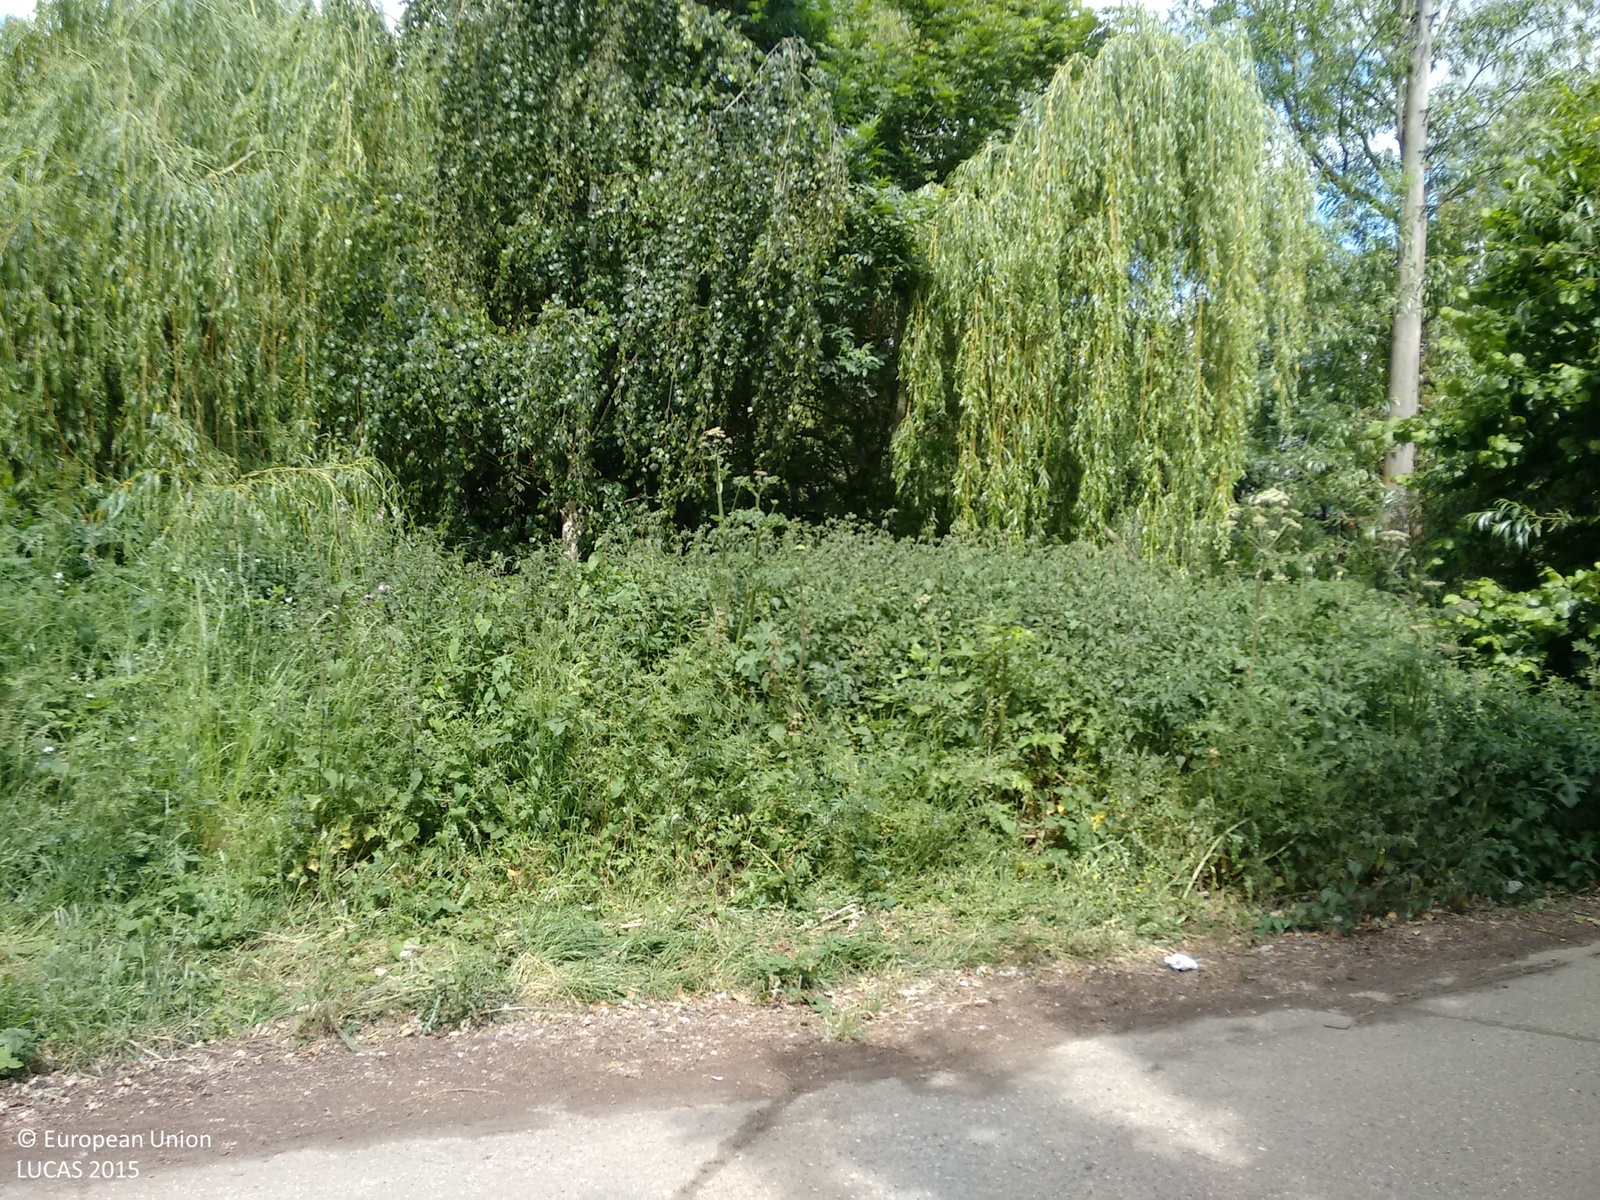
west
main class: Grassland
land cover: Grassland with sparse tree/shrub cover
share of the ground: > 75 %
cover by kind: herbaceous plants 95 %, broadleaved forest trees 5 %
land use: Semi-natural and natural areas not in use
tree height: < 5 m
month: June
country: GB
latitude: 51.4748
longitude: -0.5055
